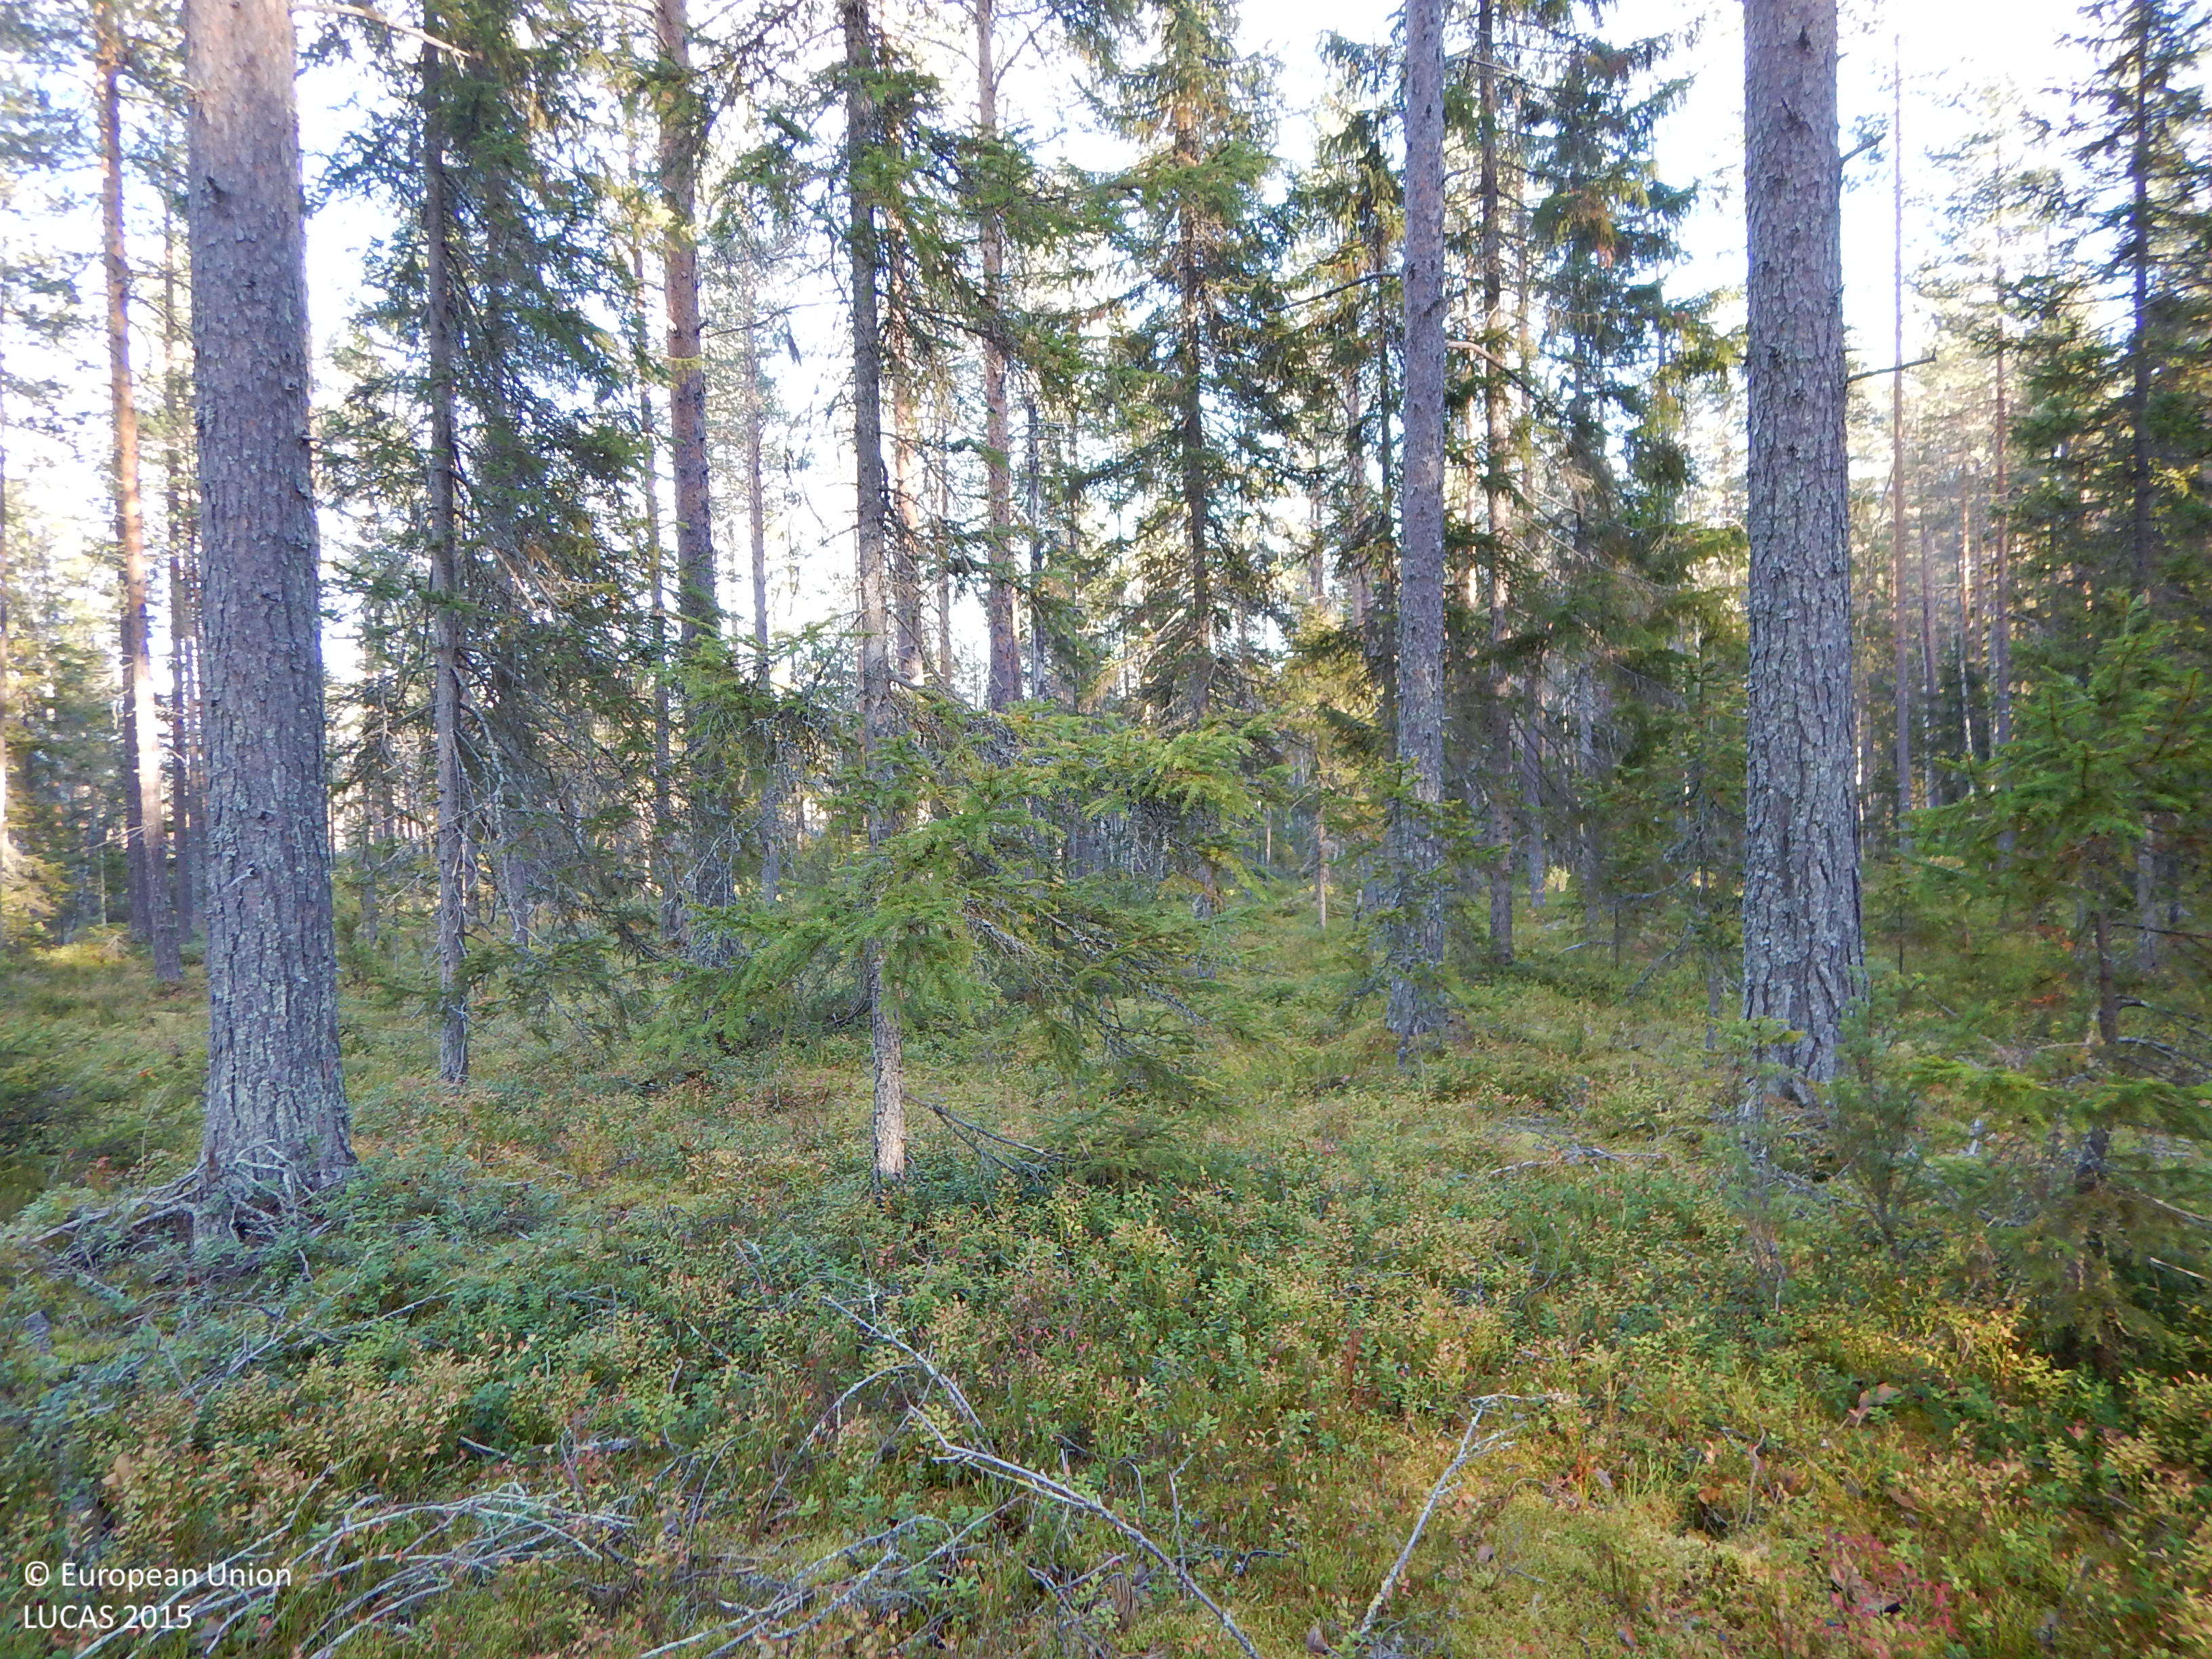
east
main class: Woodland
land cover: Pine dominated coniferous woodland
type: boreal forest
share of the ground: 50 - 75 %
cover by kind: coniferous forest trees 55 %, shrubs 15 %, lichens and mosses 15 %, herbaceous plants 10 %, broadleaved forest trees 5 %
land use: Forestry
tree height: > 5 m
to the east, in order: Pine dominated coniferous woodland; Pine dominated mixed woodland; Ditches and canals; Other mixed woodland
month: October
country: SE
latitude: 65.0412
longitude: 20.9557
